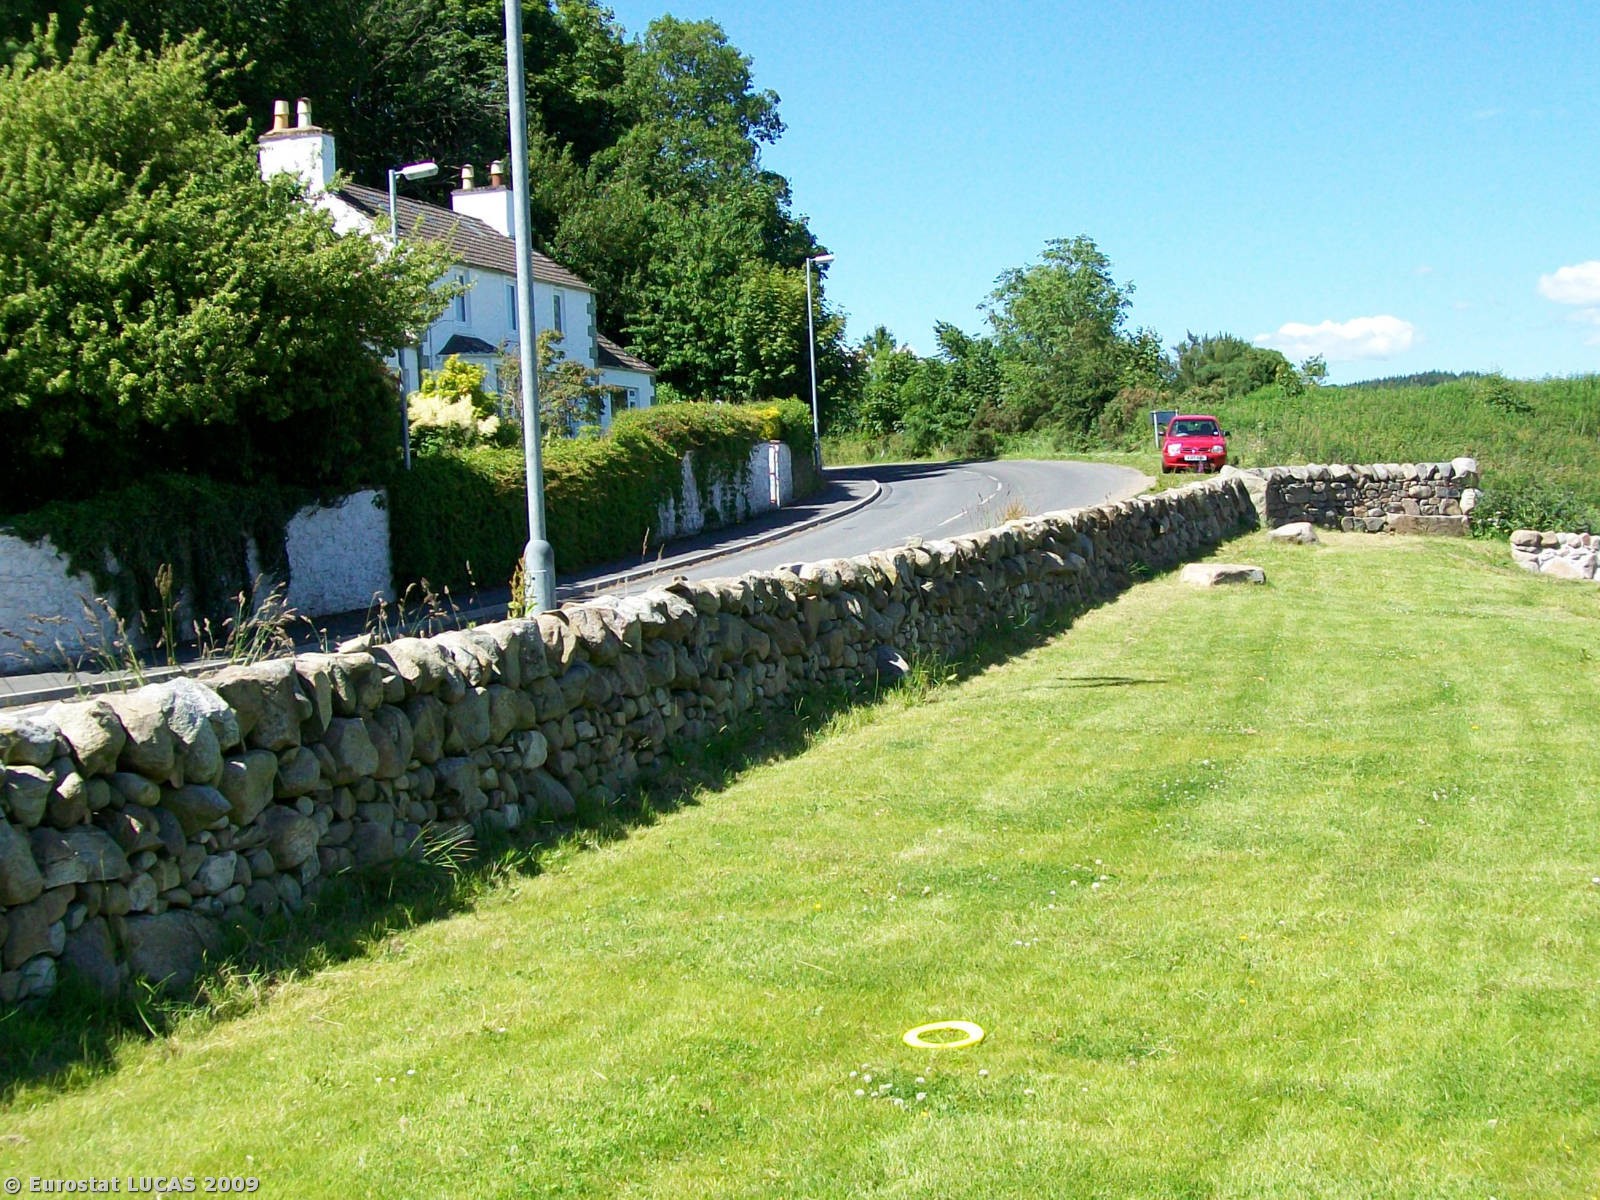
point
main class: Grassland
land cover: Grassland with sparse tree/shrub cover
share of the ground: > 75 %
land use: Amenities, museums, leisure
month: June
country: GB
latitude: 54.8447
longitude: -3.8705
